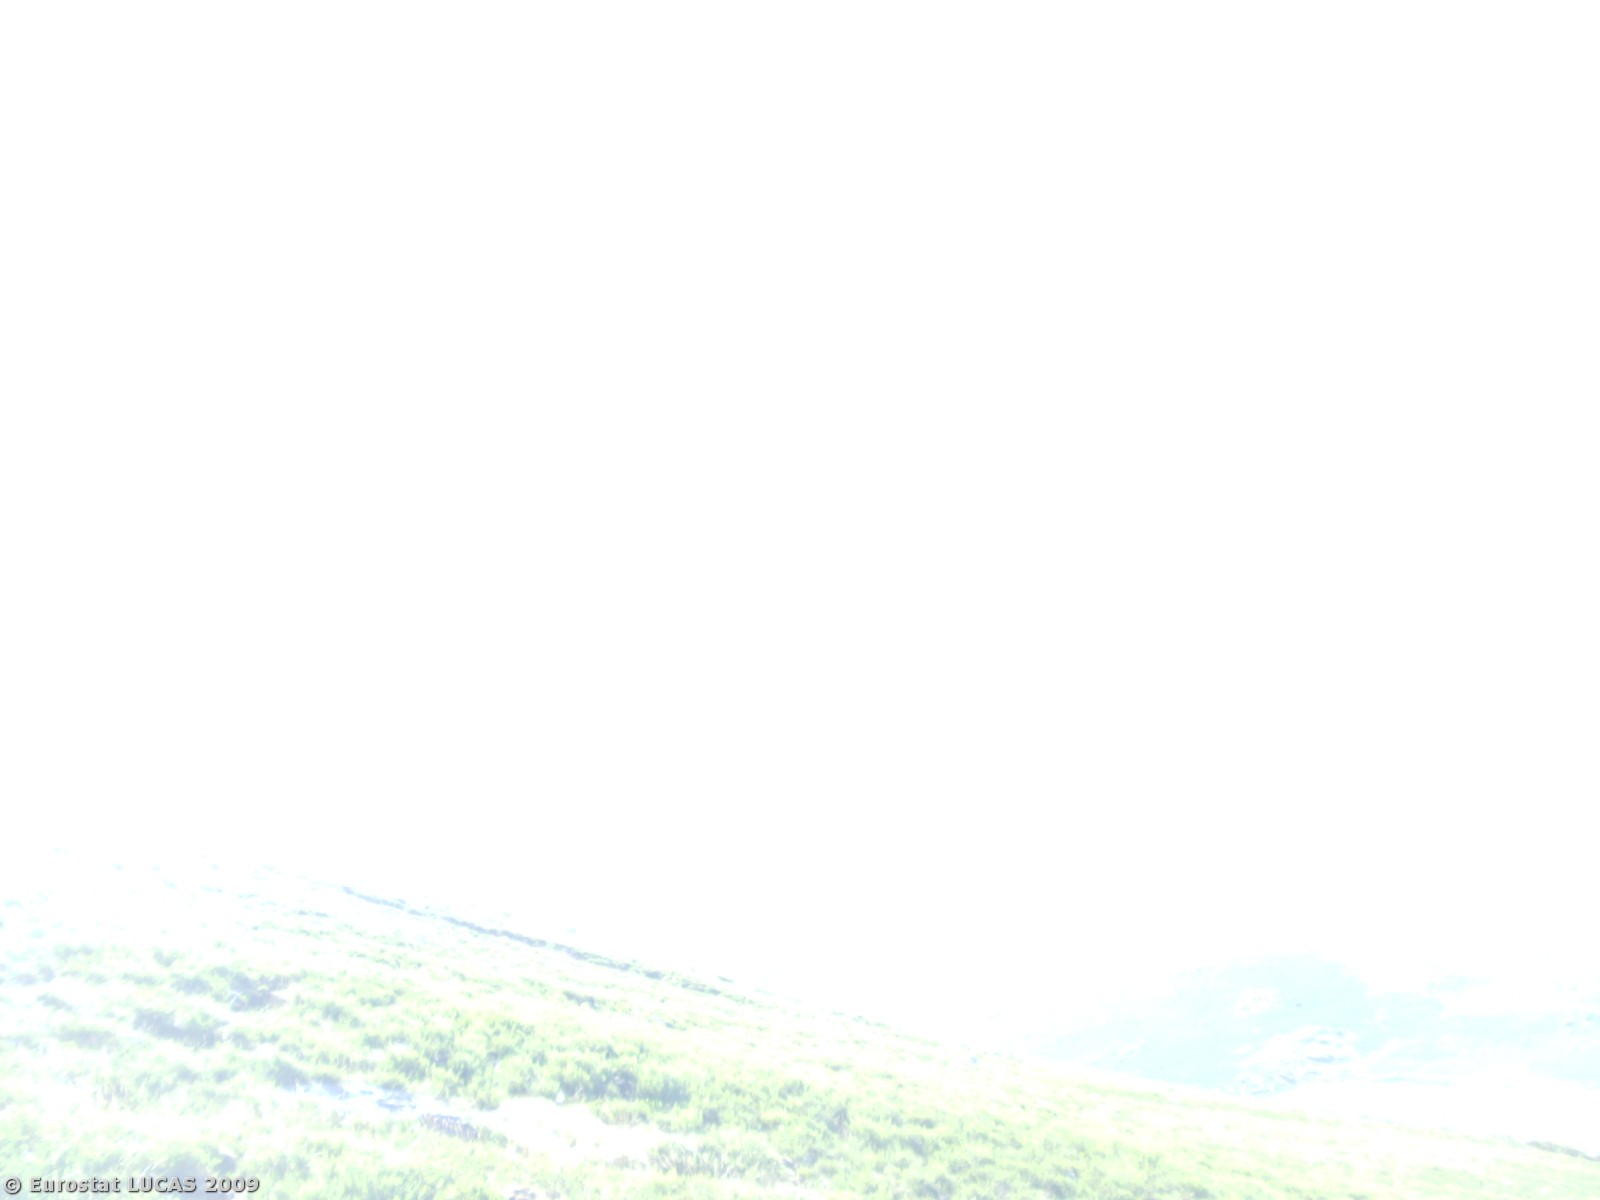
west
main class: Shrubland
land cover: Shrubland without tree cover
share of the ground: > 75 %
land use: Nature reserves
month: August
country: PT
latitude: 41.2991
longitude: -7.9178
